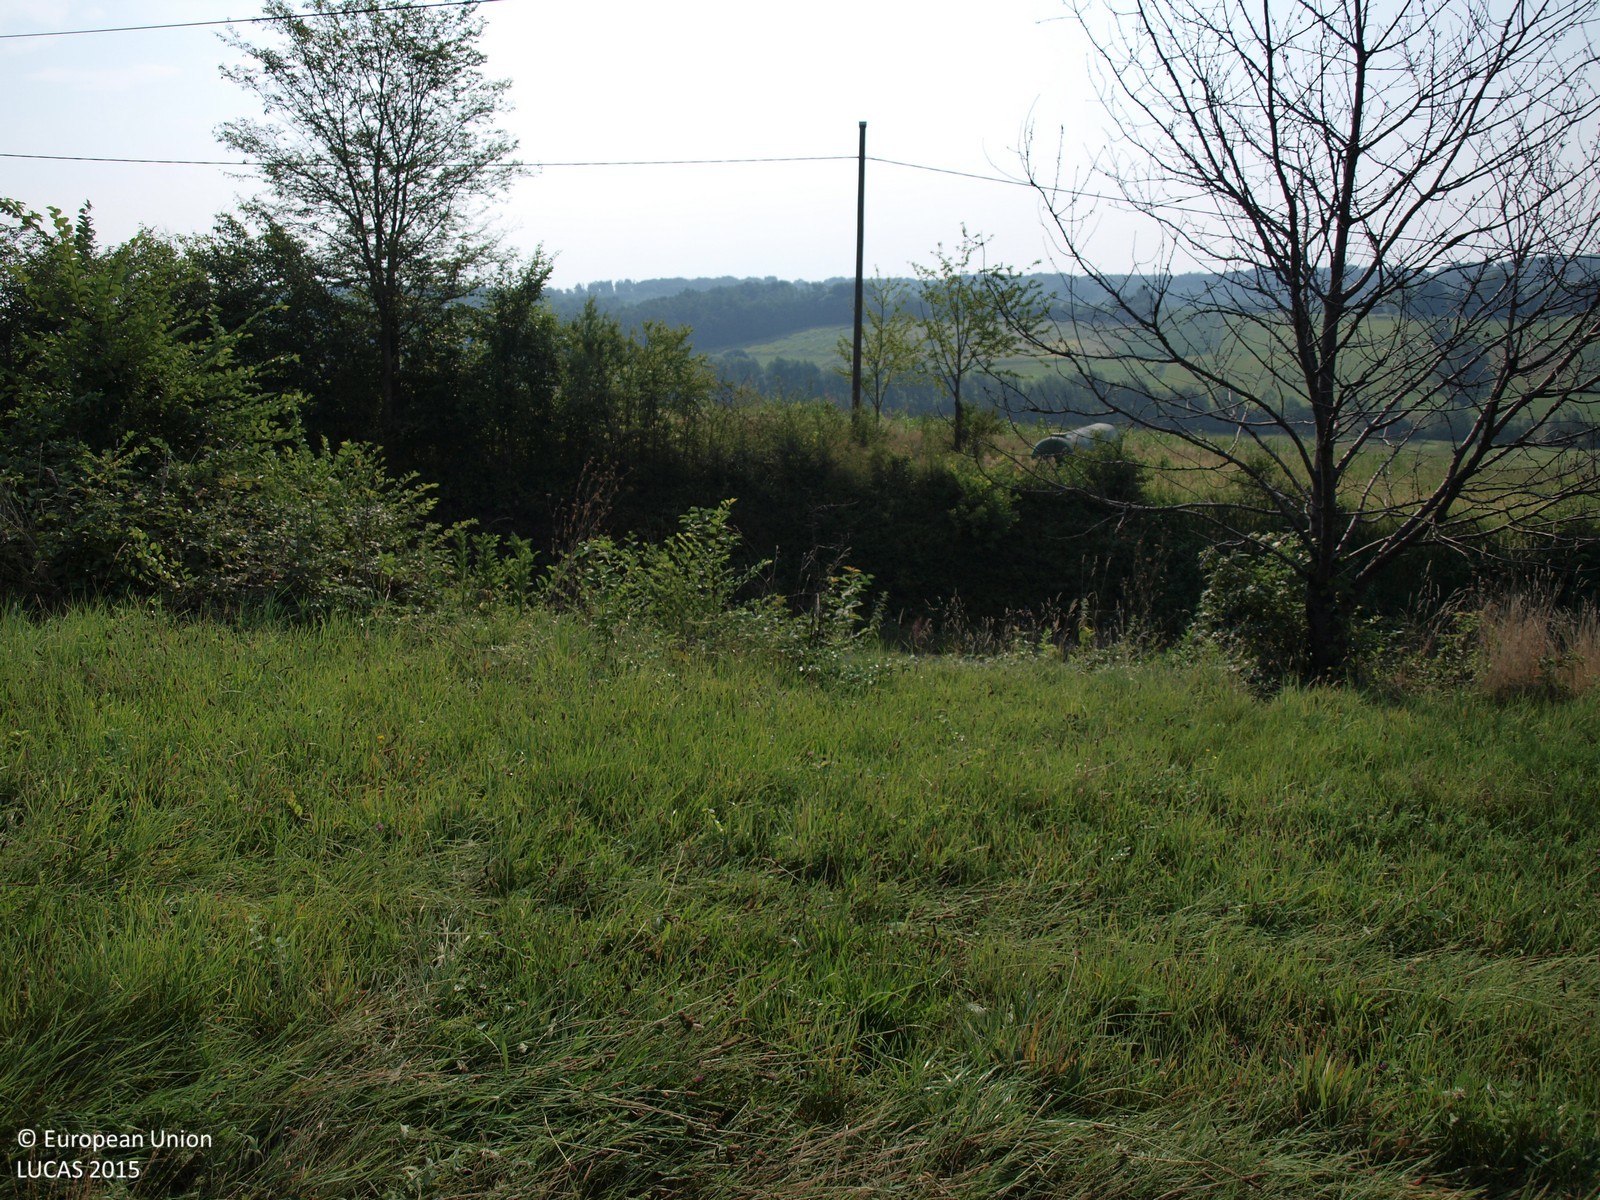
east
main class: Grassland
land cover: Grassland without tree/shrub cover
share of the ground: > 75 %
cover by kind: herbaceous plants 100 %
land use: Agriculture (excluding fallow land and kitchen gardens)
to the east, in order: Grassland without tree/shrub cover; Electric lines; Paved roads, cycling and walking lanes; Abandoned hedges; Electric lines; Grassland without tree/shrub cover; Maize; Grassland without tree/shrub cover; Maize
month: August
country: HR
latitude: 45.9436
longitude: 16.3844
